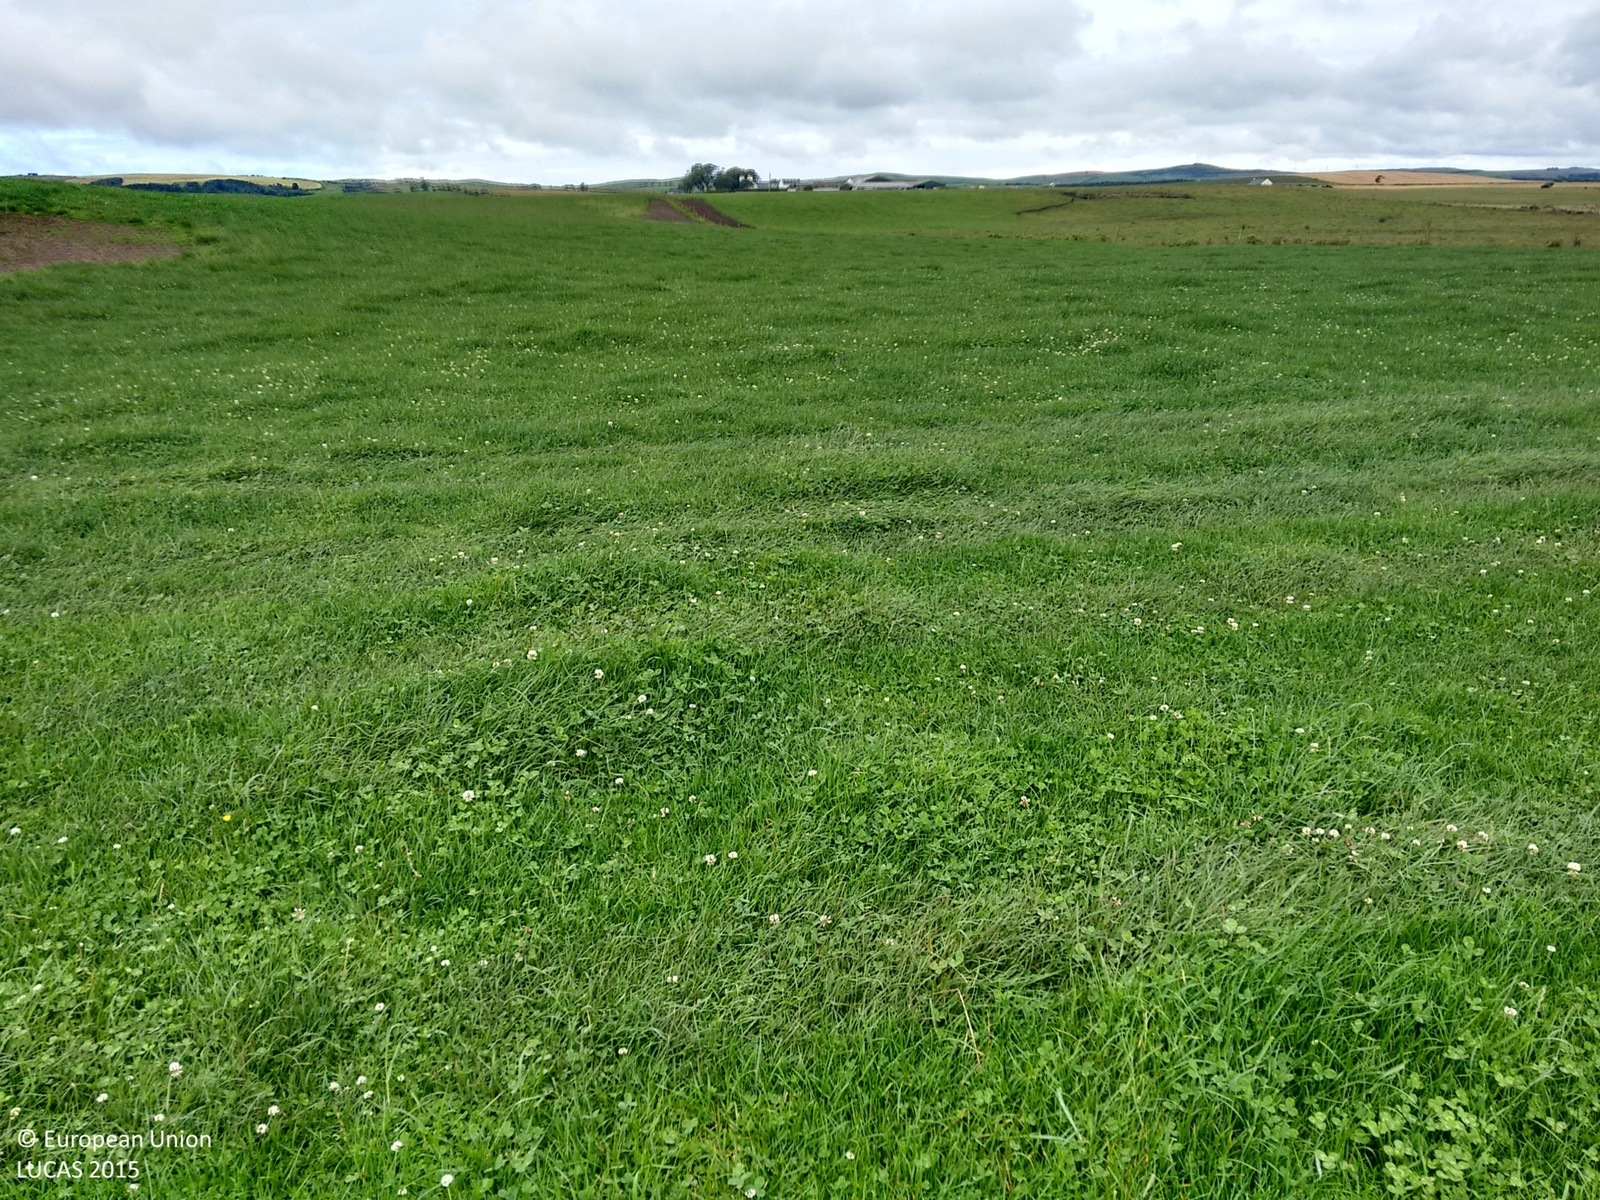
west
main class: Grassland
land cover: Grassland without tree/shrub cover
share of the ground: > 75 %
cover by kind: herbaceous plants 100 %
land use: Agriculture (excluding fallow land and kitchen gardens)
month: August
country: GB
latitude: 54.8462
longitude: -4.9543
